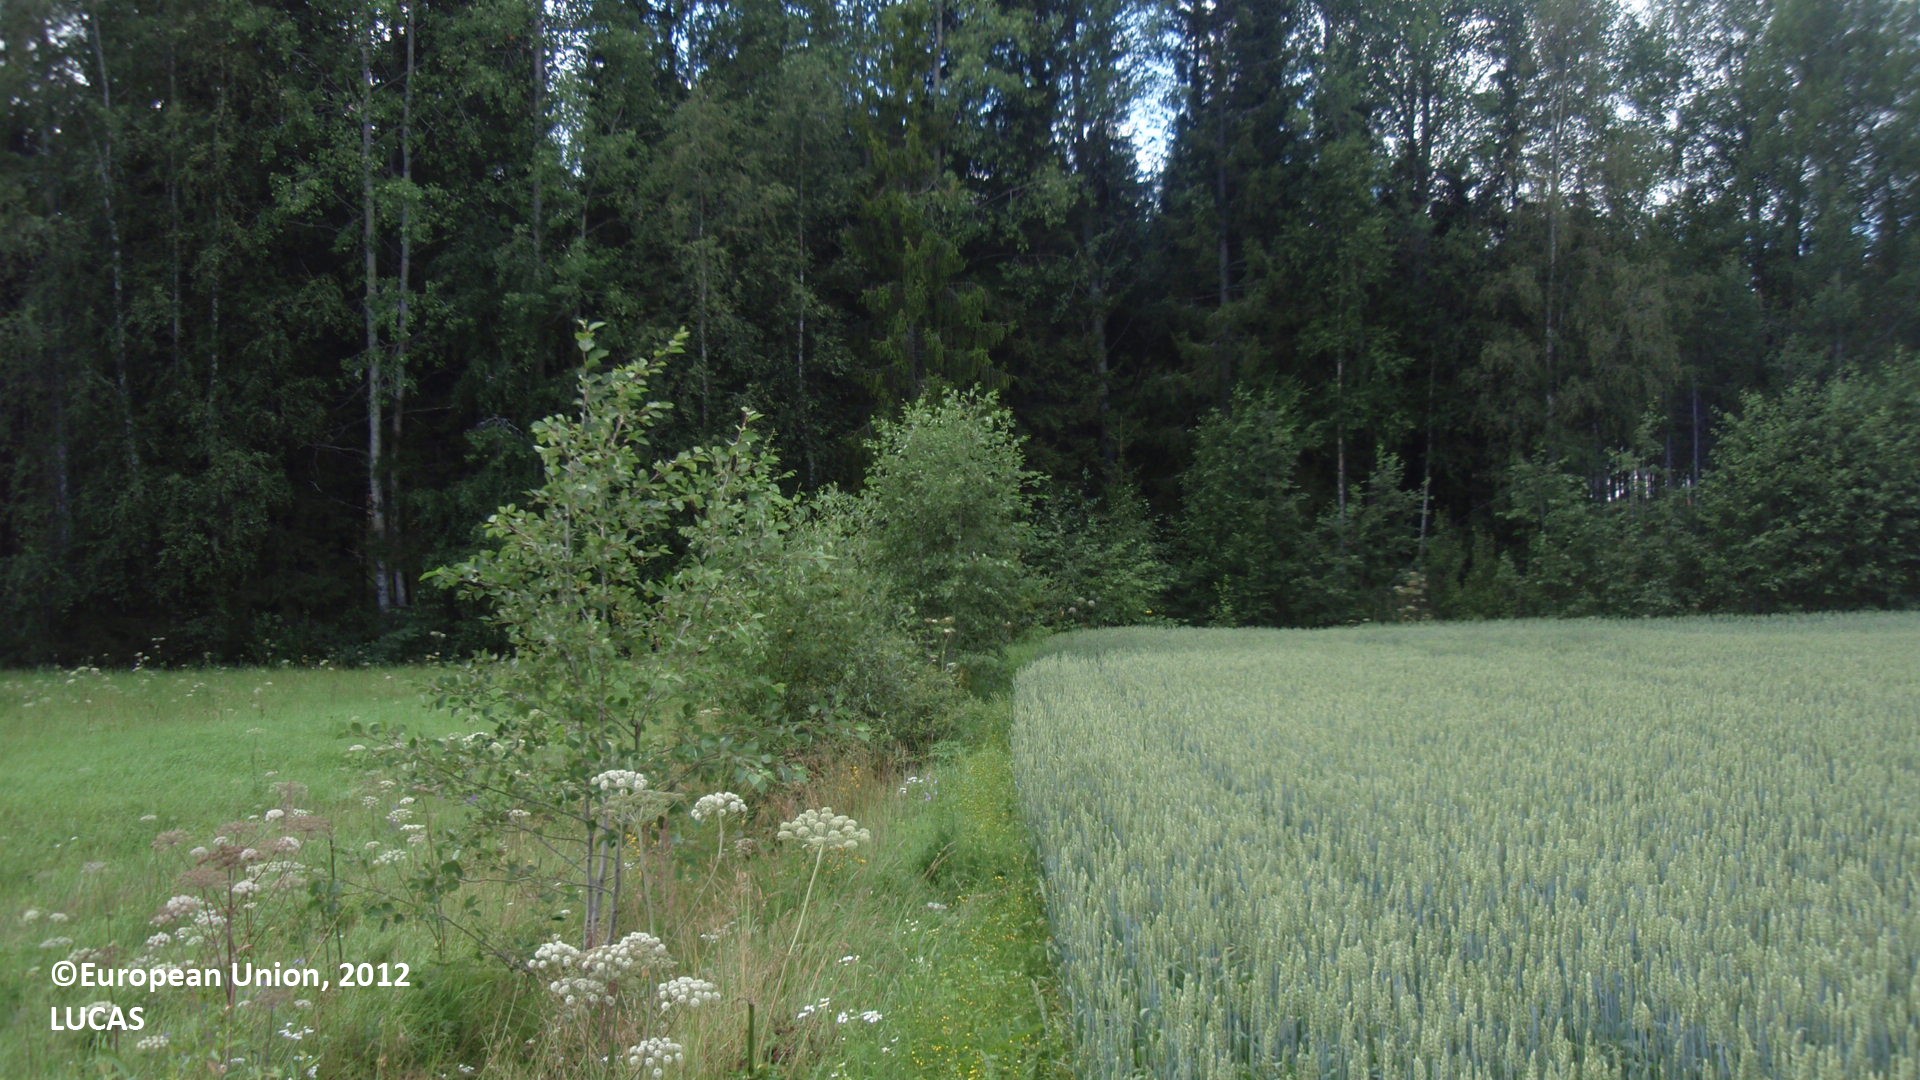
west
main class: Cropland
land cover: Oats
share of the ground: > 75 %
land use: Agriculture (excluding fallow land and kitchen gardens)
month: July
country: FI
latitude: 60.9667
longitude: 28.4848
